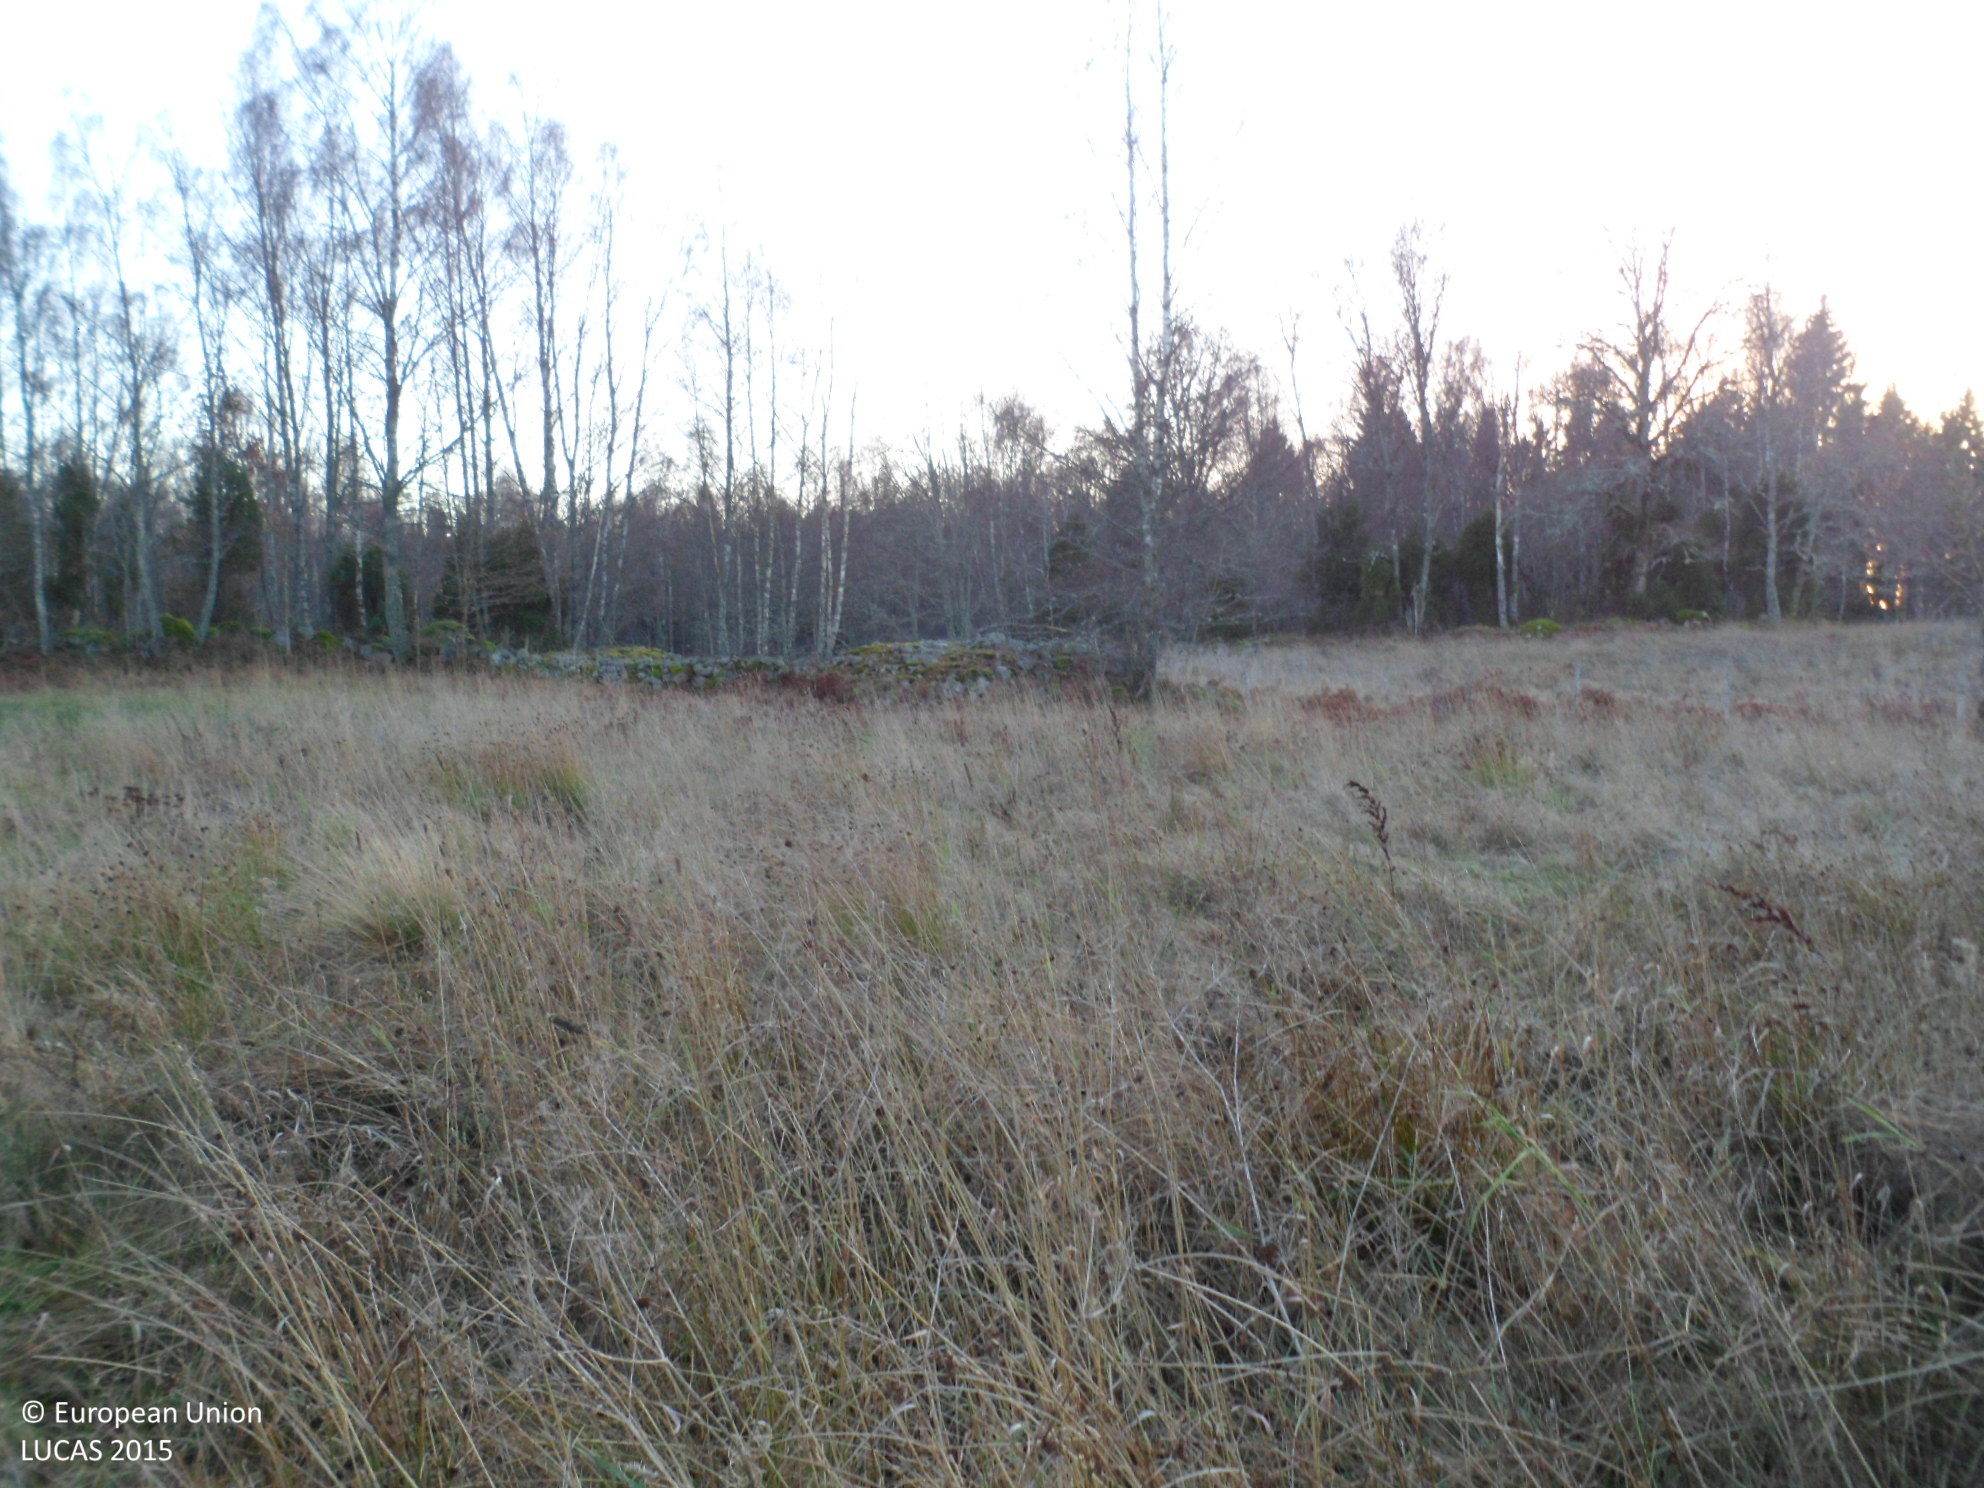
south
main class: Grassland
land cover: Grassland with sparse tree/shrub cover
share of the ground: > 75 %
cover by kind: herbaceous plants 90 %, broadleaved forest trees 5 %, shrubs 5 %
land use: Agriculture (excluding fallow land and kitchen gardens)
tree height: < 5 m
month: November
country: SE
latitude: 56.8162
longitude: 16.1431
